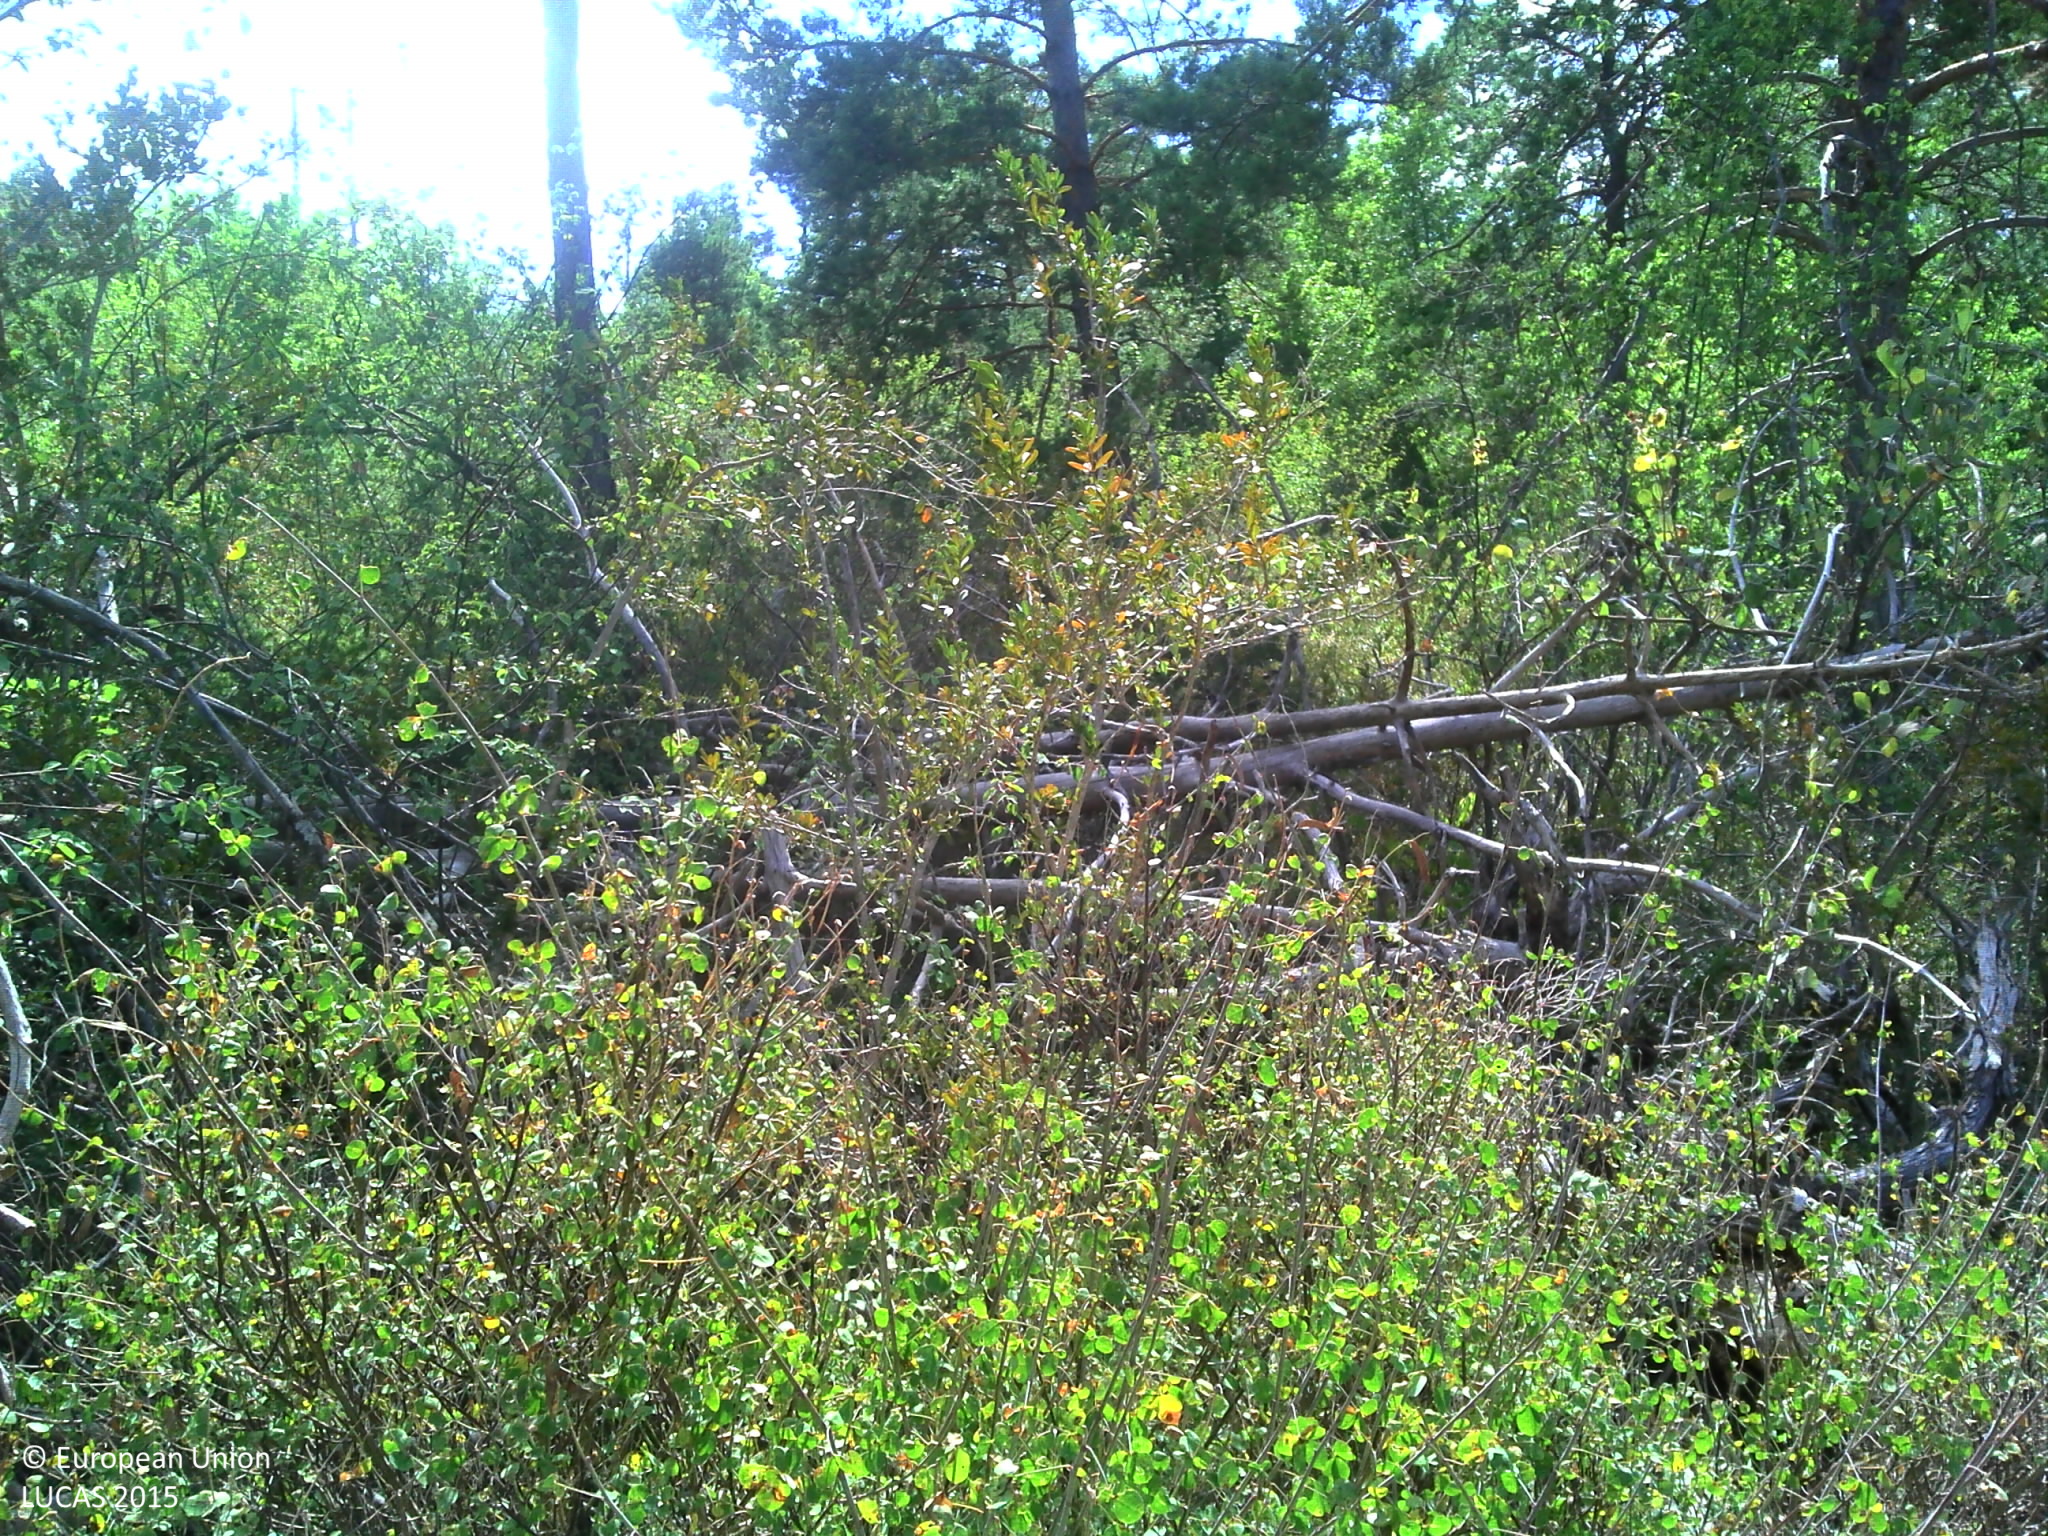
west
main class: Woodland
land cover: Pine dominated coniferous woodland
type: alpine coniferous forest
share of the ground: 10 - 25 %
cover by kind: coniferous forest trees 30 %, shrubs 20 %, herbaceous plants 10 %, consolidated bare surface 10 %
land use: Semi-natural and natural areas not in use
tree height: > 5 m
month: August
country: FR
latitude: 43.9404
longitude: 6.8053
